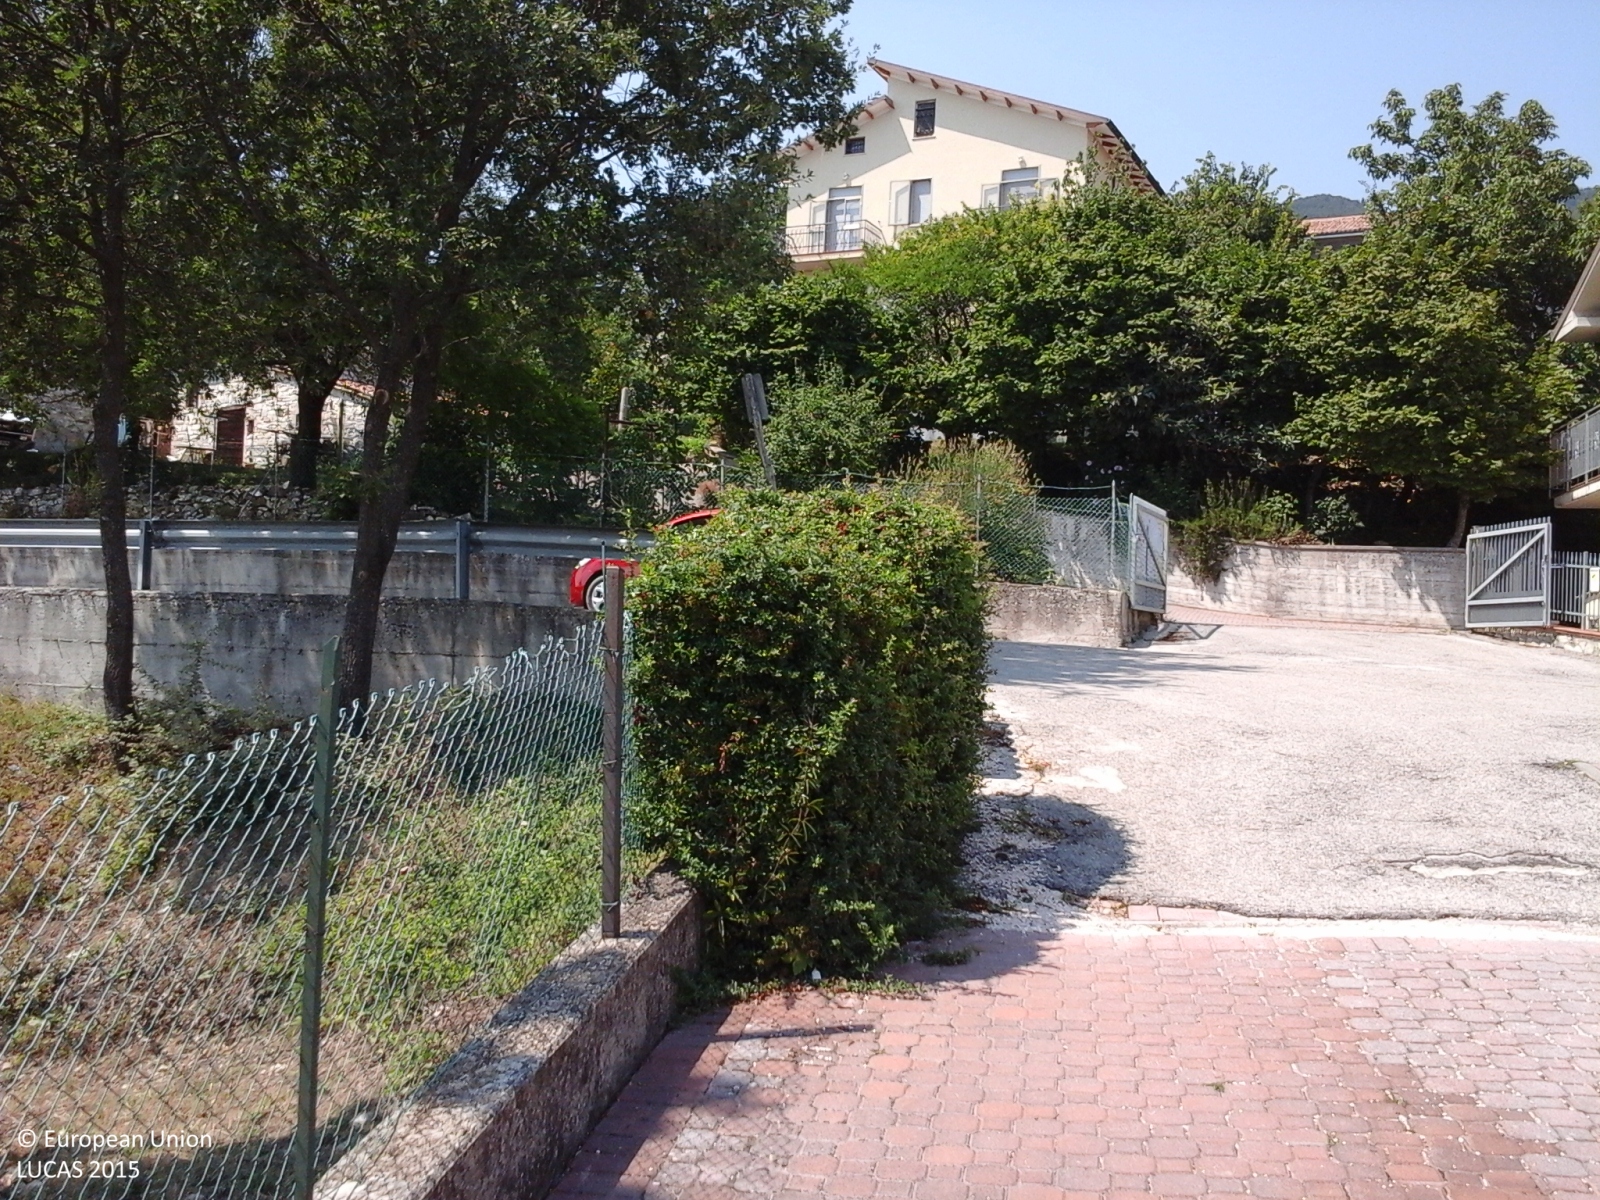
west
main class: Grassland
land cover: Grassland without tree/shrub cover
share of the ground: > 75 %
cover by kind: herbaceous plants 100 %
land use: Residential
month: August
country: IT
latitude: 43.7827
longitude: 12.3426
